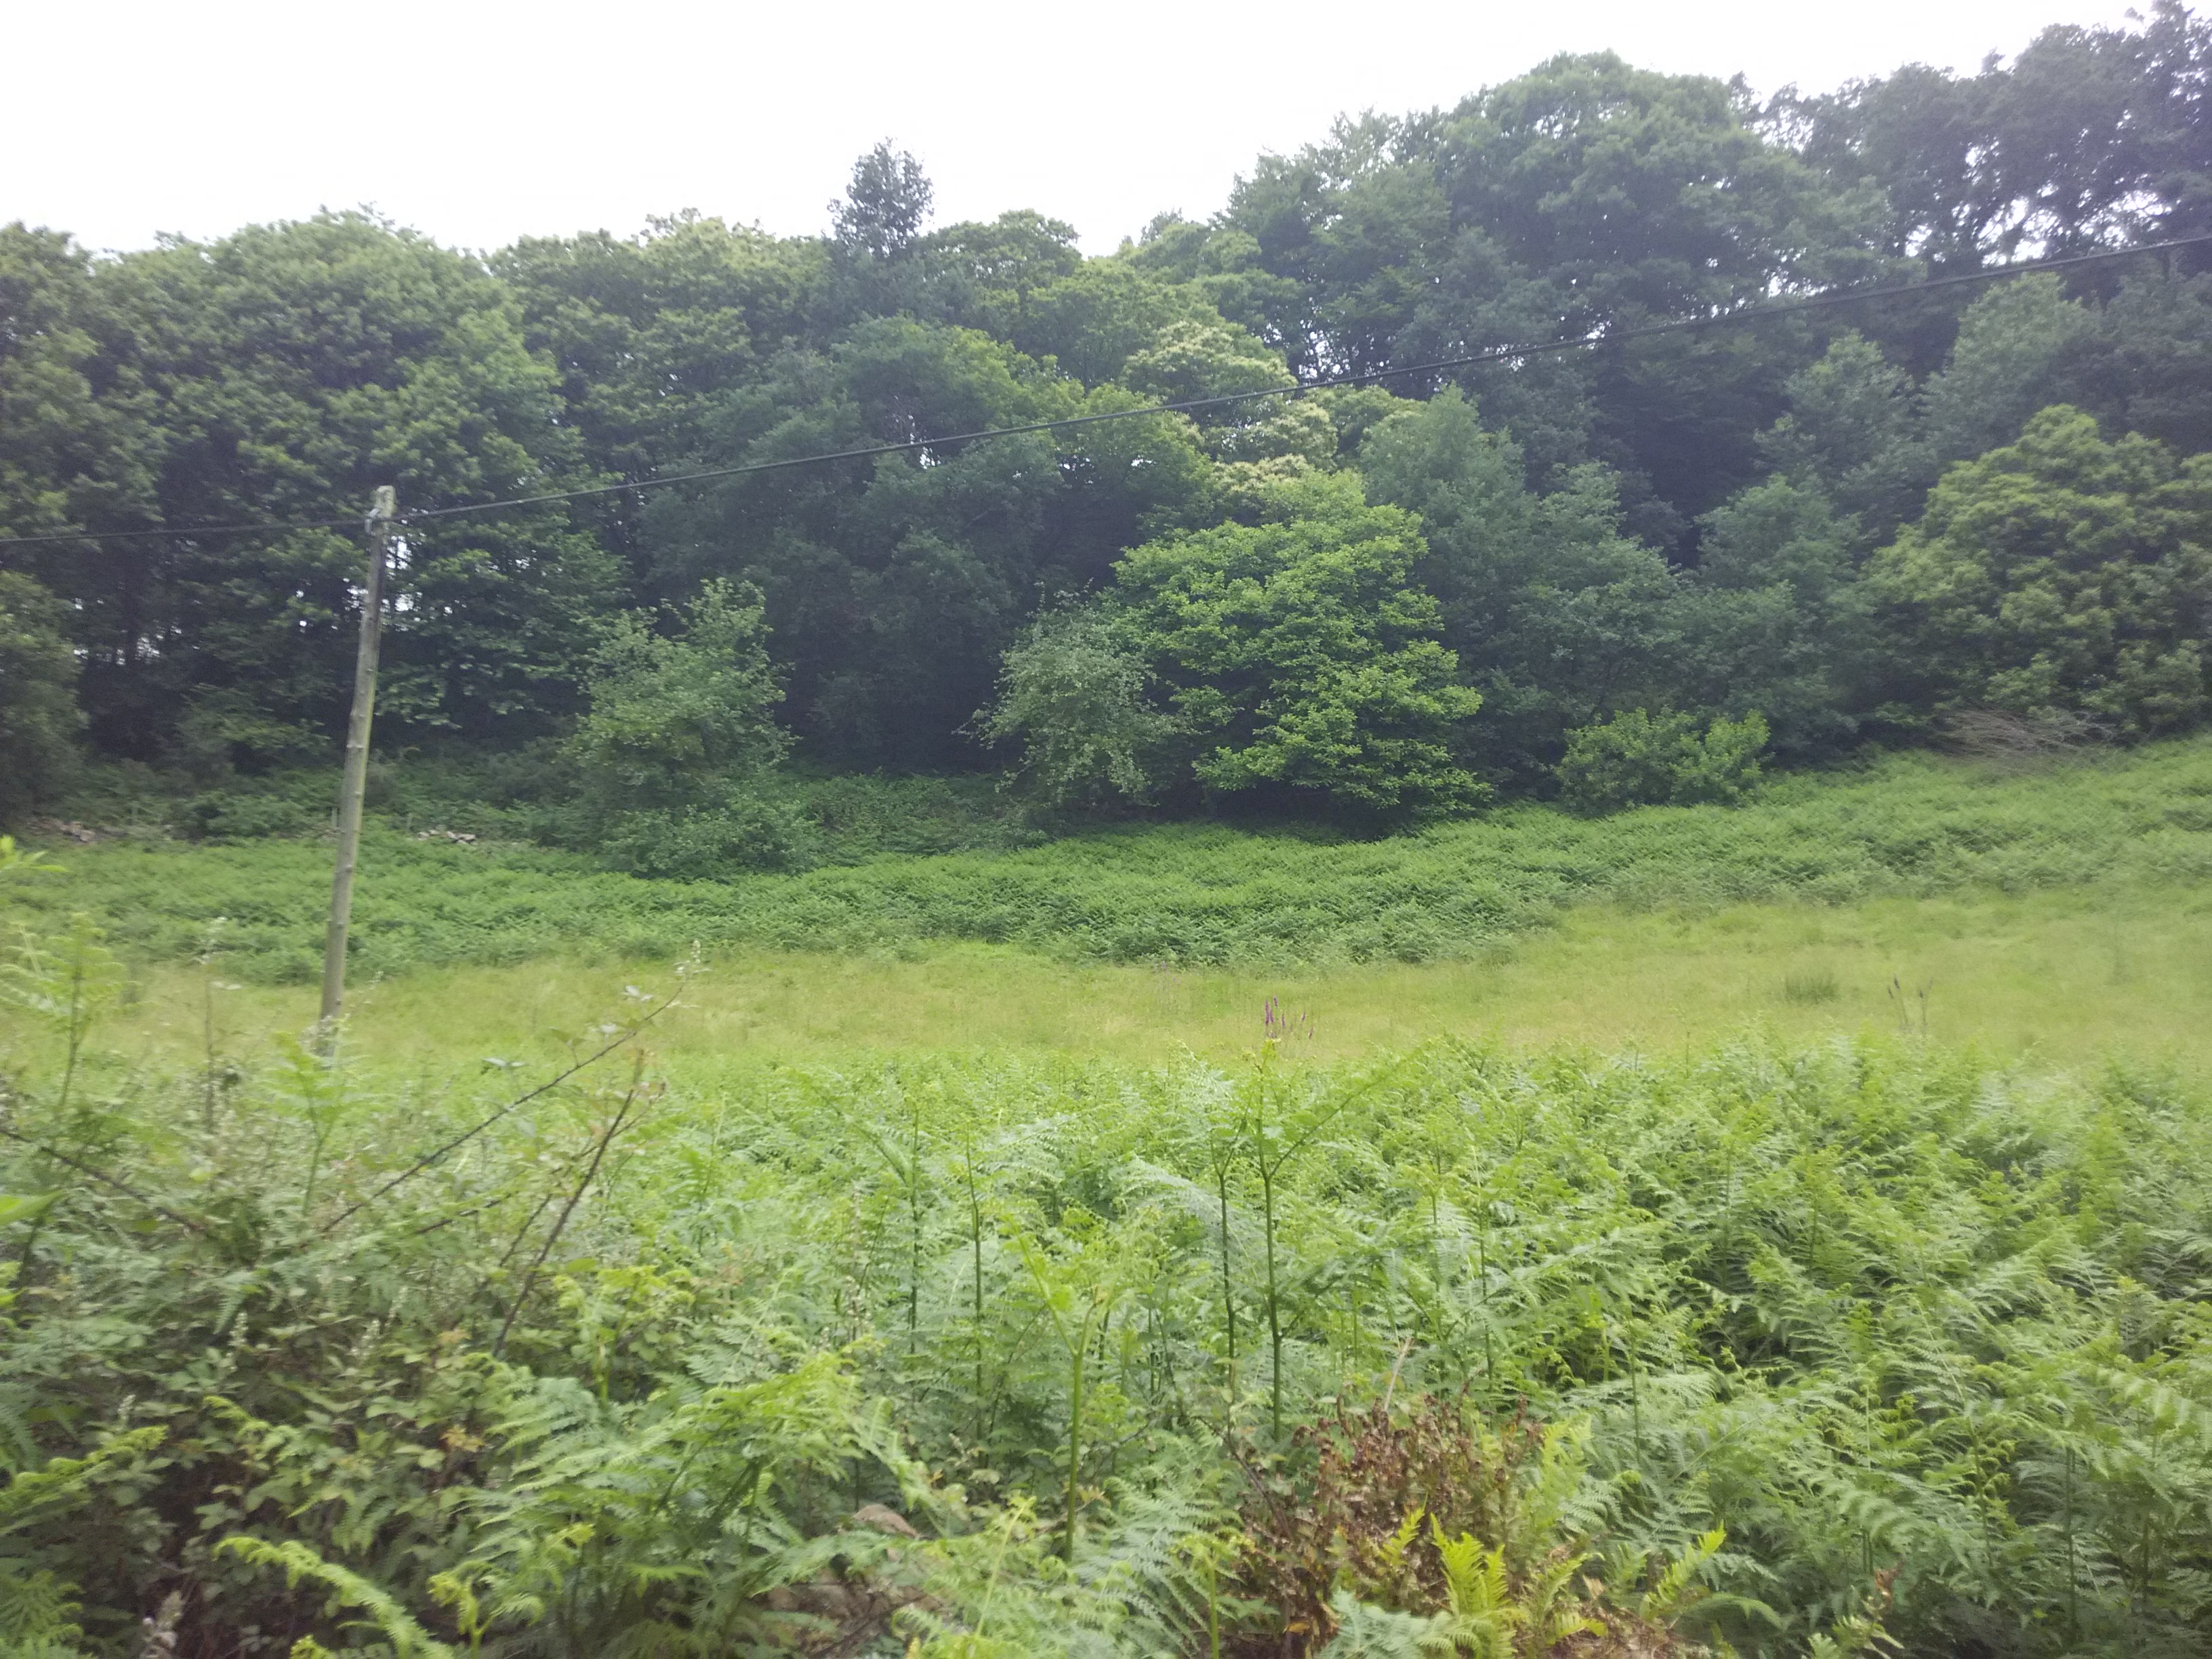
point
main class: Grassland
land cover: Grassland without tree/shrub cover
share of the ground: > 75 %
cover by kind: herbaceous plants 85 %, consolidated bare surface 10 %, shrubs 5 %
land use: Agriculture (excluding fallow land and kitchen gardens)
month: June
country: ES
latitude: 43.2726
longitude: -1.8117
